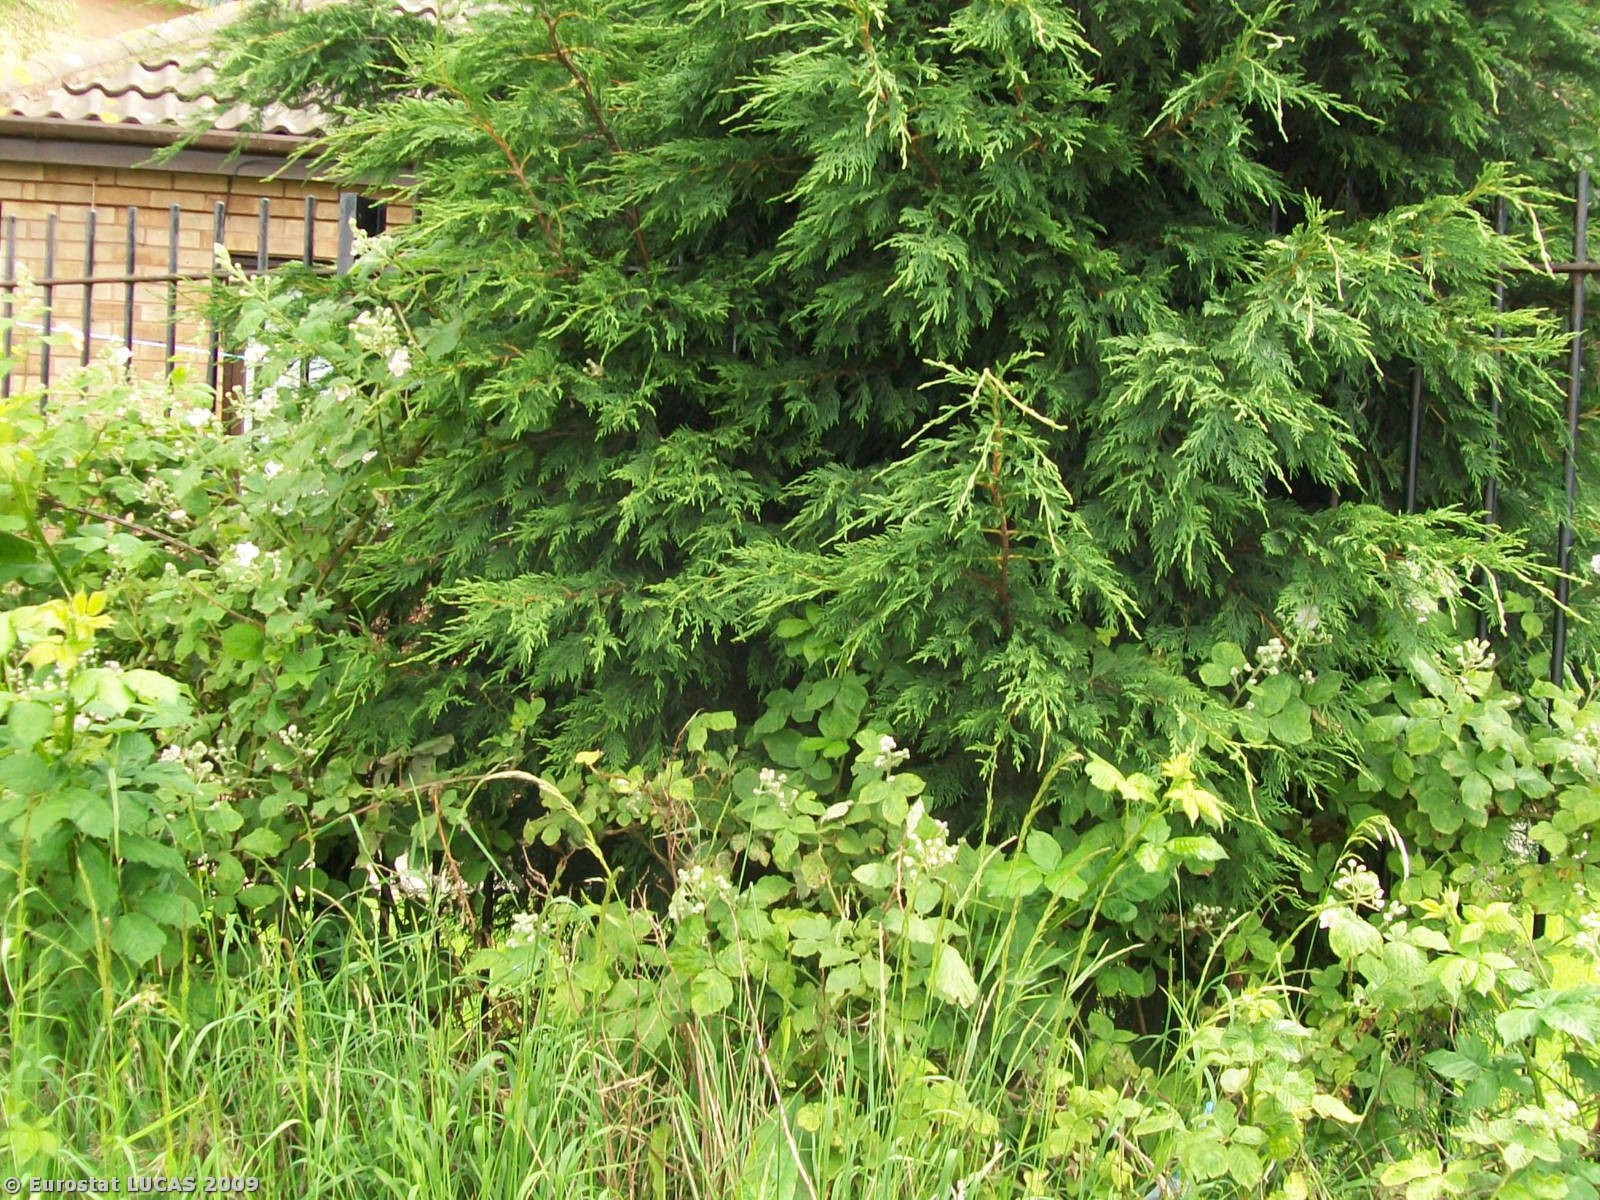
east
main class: Grassland
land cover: Grassland without tree/shrub cover
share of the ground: < 10 %
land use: Amenities, museums, leisure
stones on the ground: < 10 %
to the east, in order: Grassland without tree/shrub cover; Artificial constructions in urban areas
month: June
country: GB
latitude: 53.3777
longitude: -2.7725
